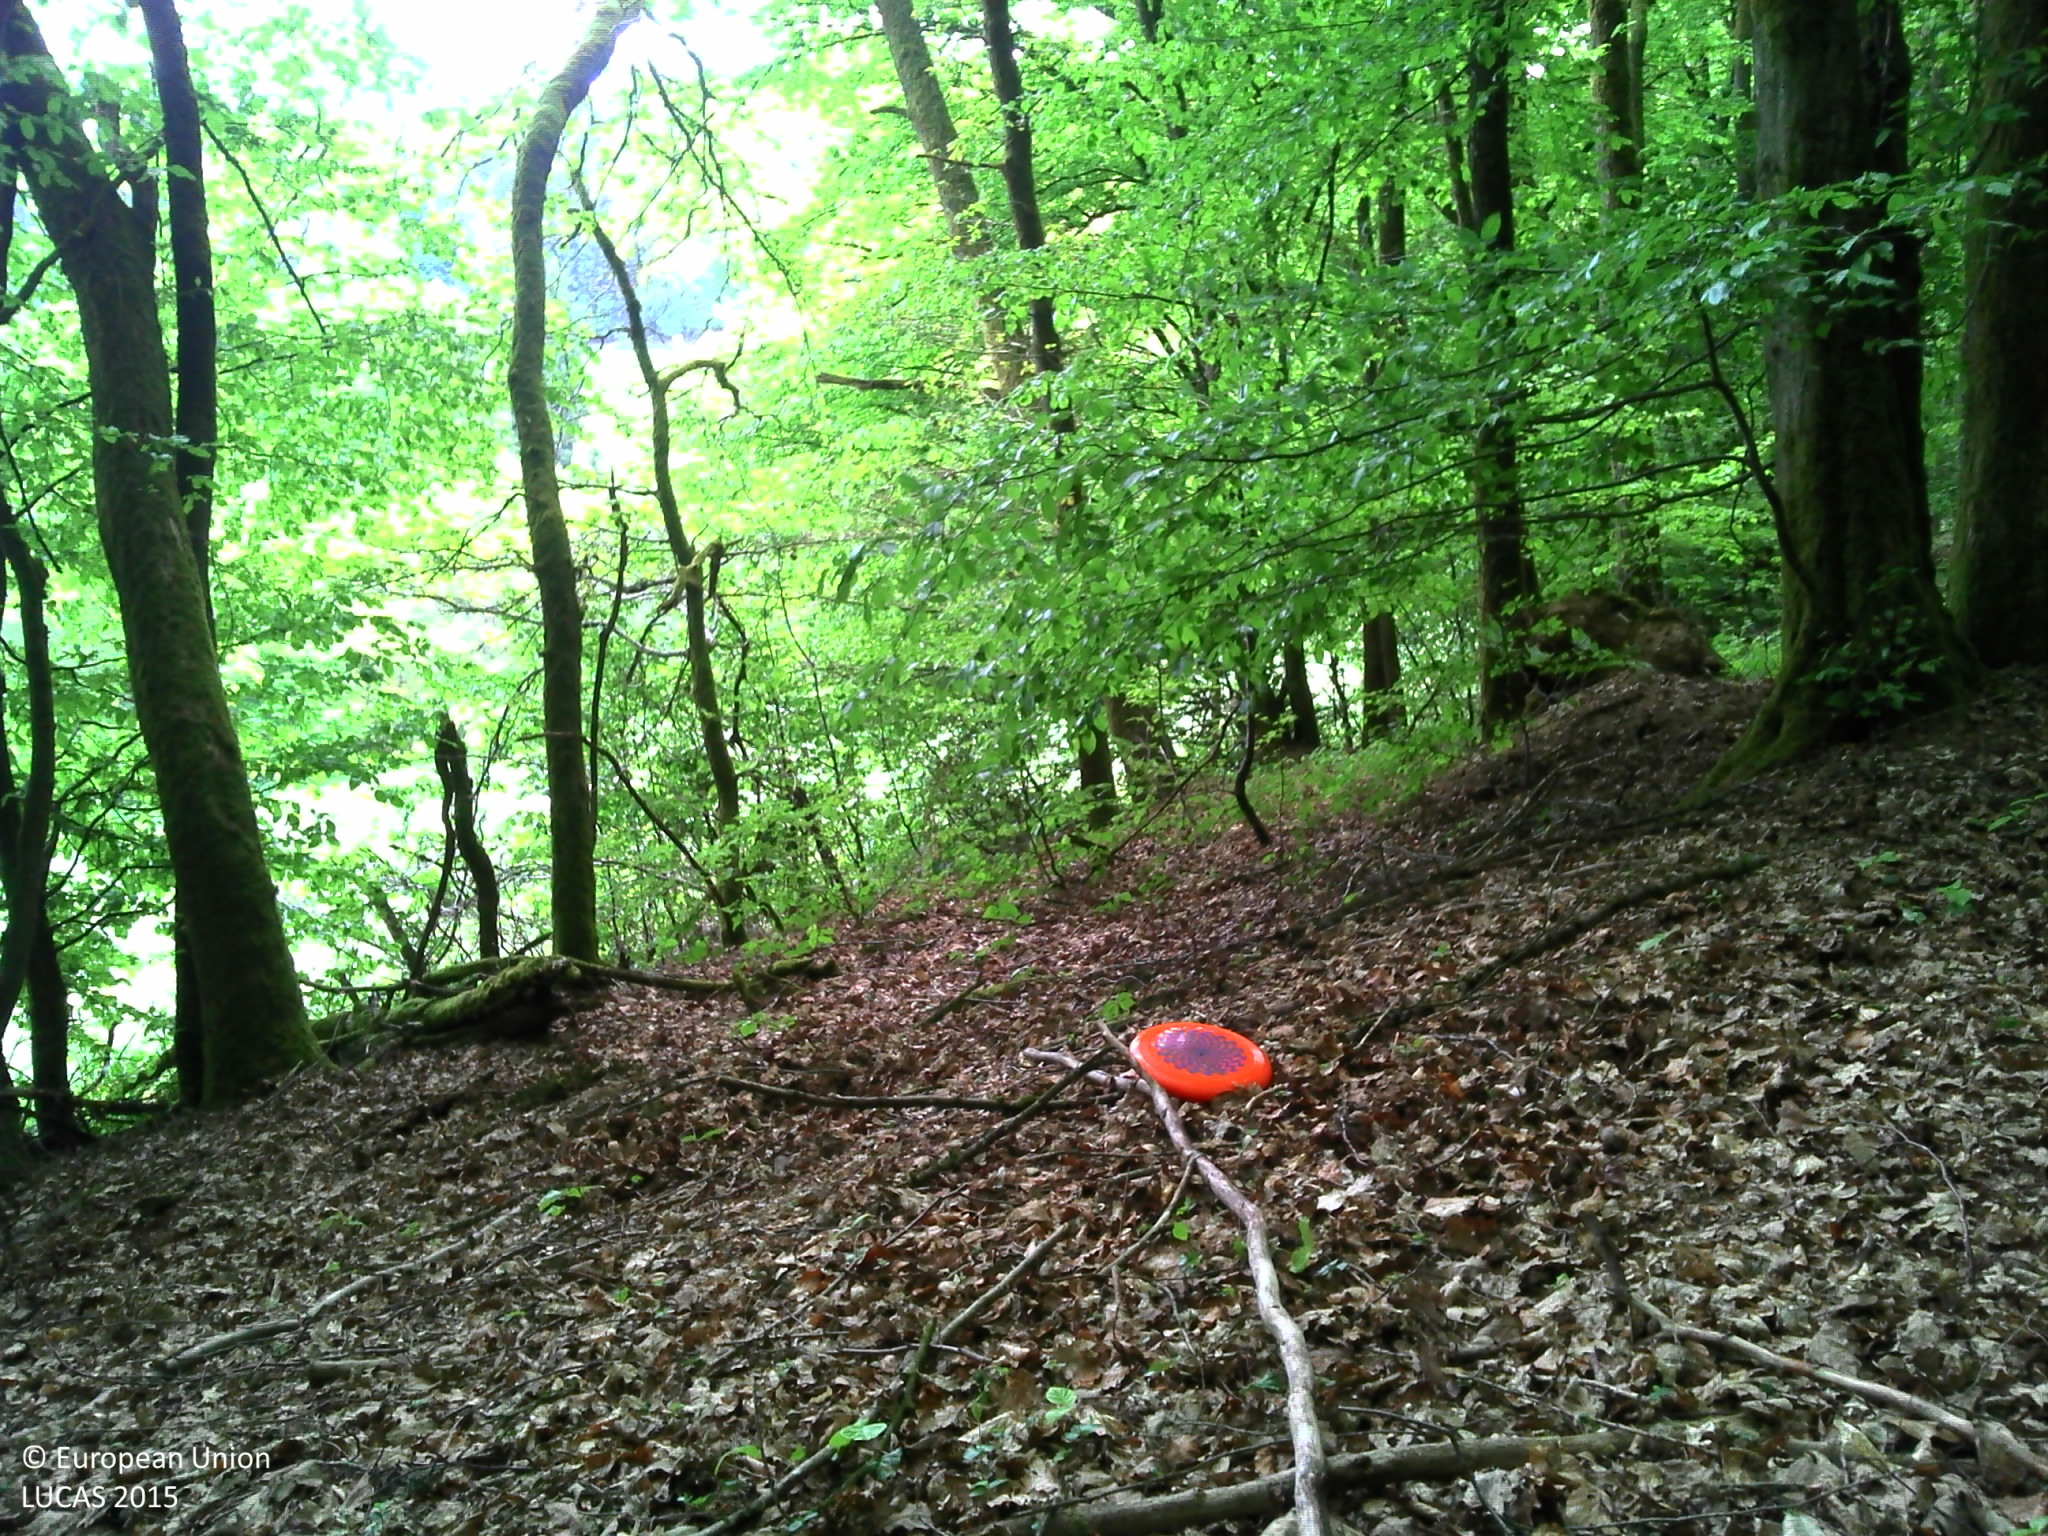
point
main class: Woodland
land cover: Broadleaved woodland
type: beech forest
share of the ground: > 75 %
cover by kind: broadleaved forest trees 90 %, lichens and mosses 10 %
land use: Forestry
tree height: > 5 m
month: May
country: LU
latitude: 49.9830
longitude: 5.8569
